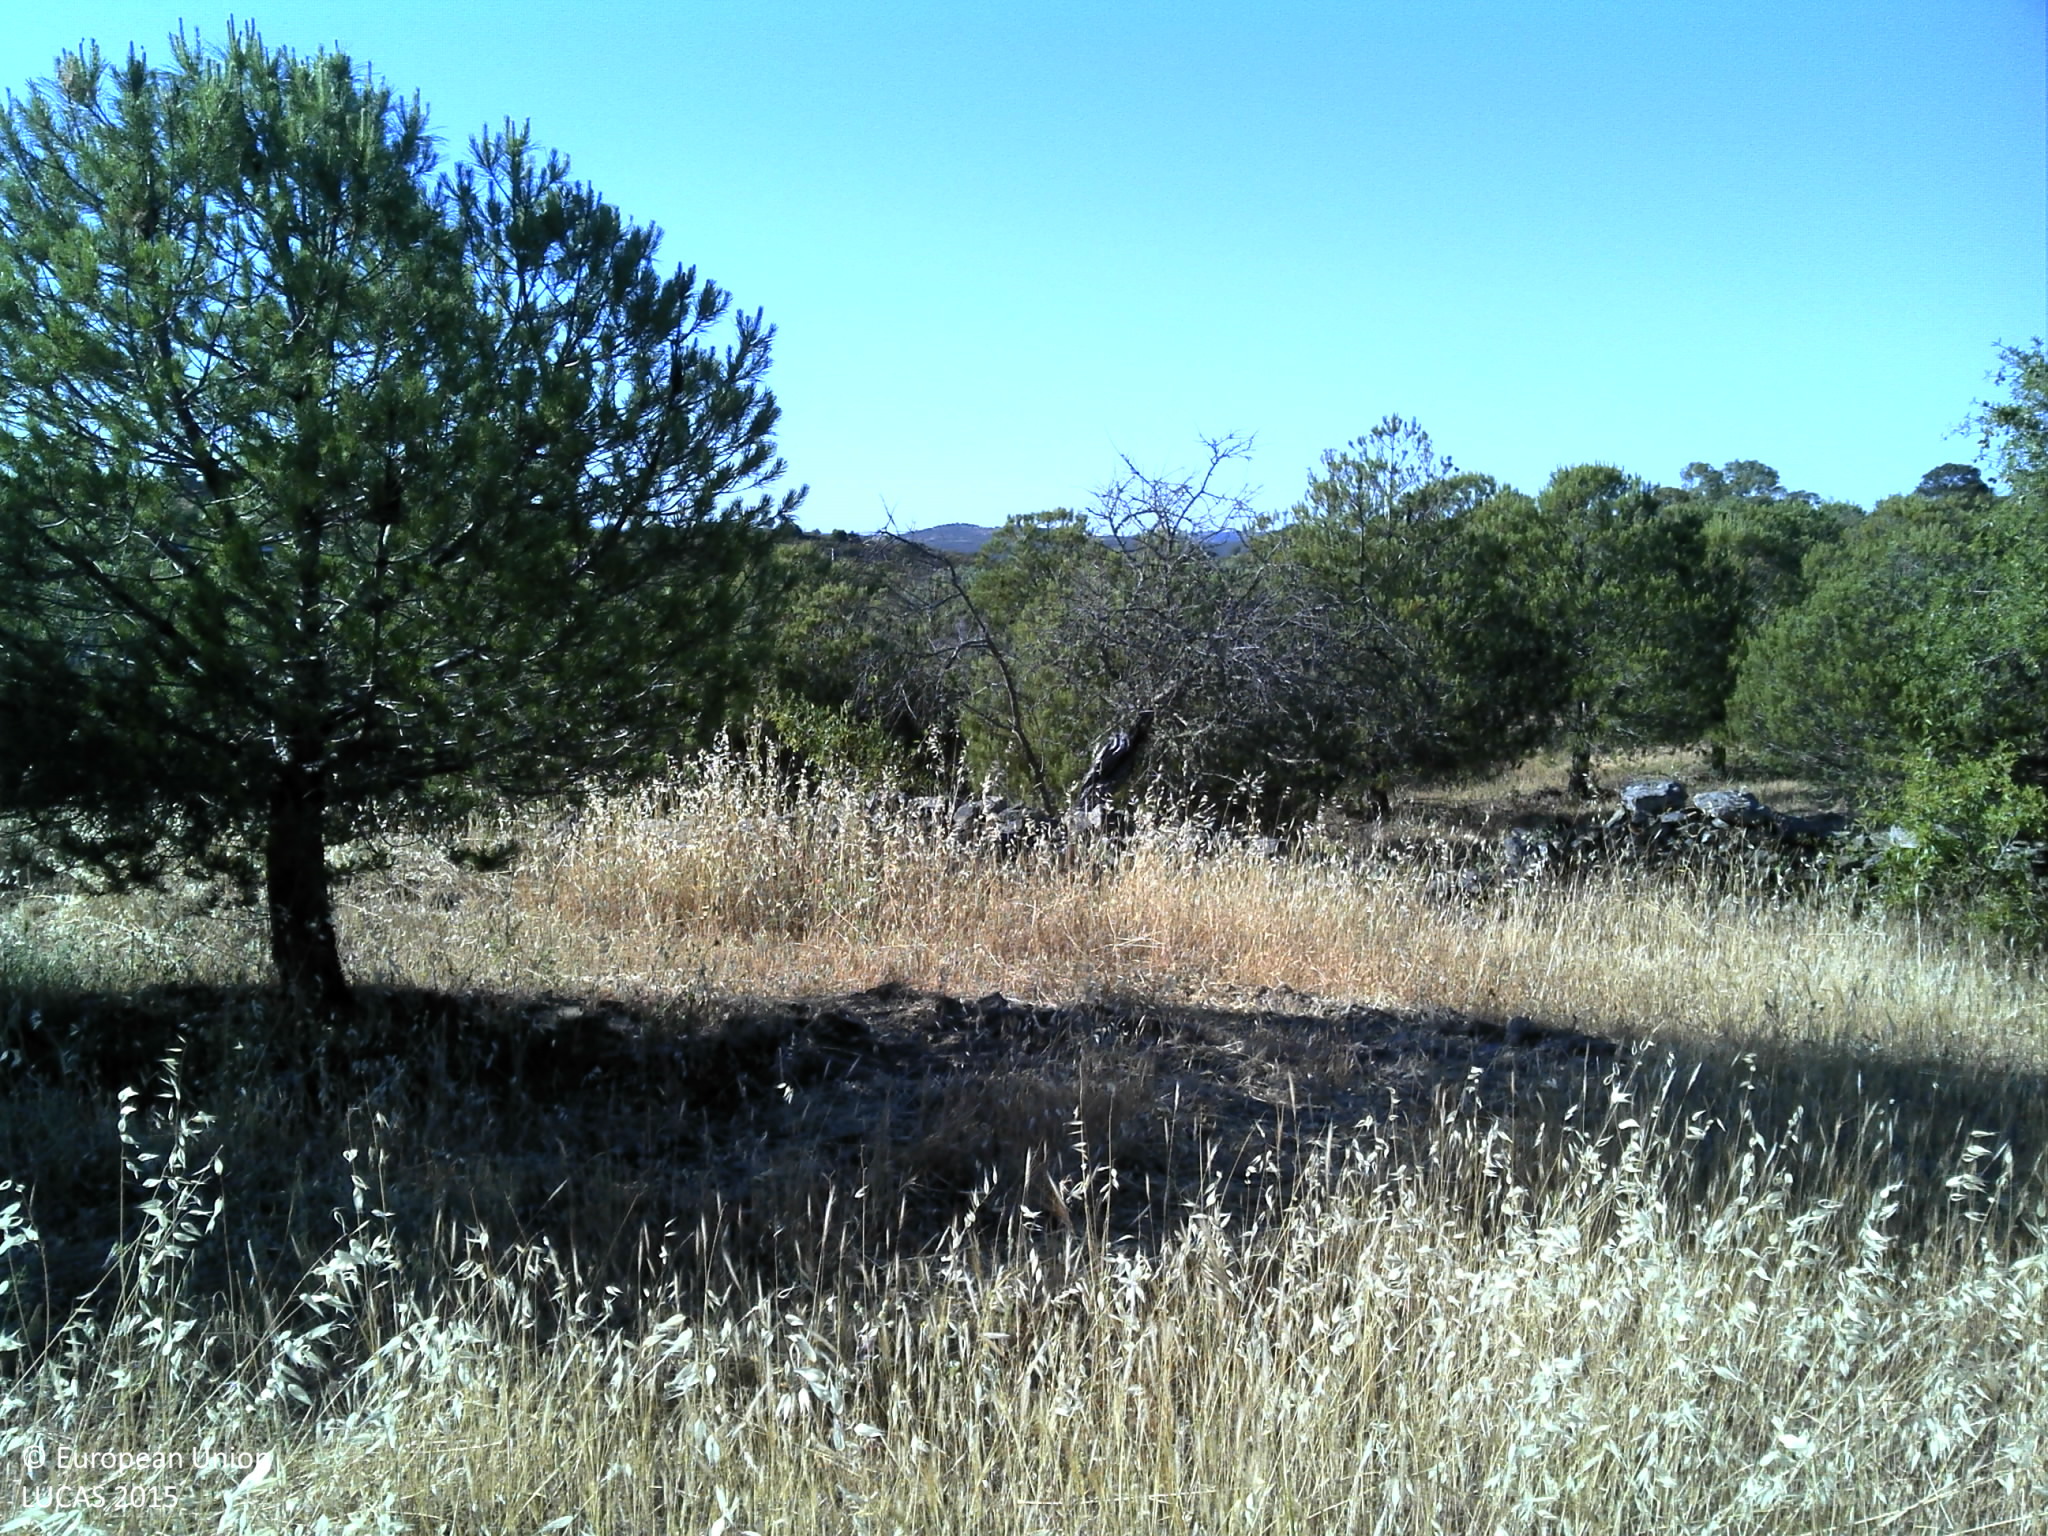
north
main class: Woodland
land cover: Pine dominated coniferous woodland
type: coniferous forest of the mediterranean region
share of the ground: 25 - 50 %
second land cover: Grassland without tree/shrub cover
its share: 50 - 75 %
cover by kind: herbaceous plants 40 %, coniferous forest trees 35 %, shrubs 25 %
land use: Forestry
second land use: Agriculture (excluding fallow land and kitchen gardens)
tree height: < 5 m
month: May
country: PT
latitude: 37.4439
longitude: -7.4938
